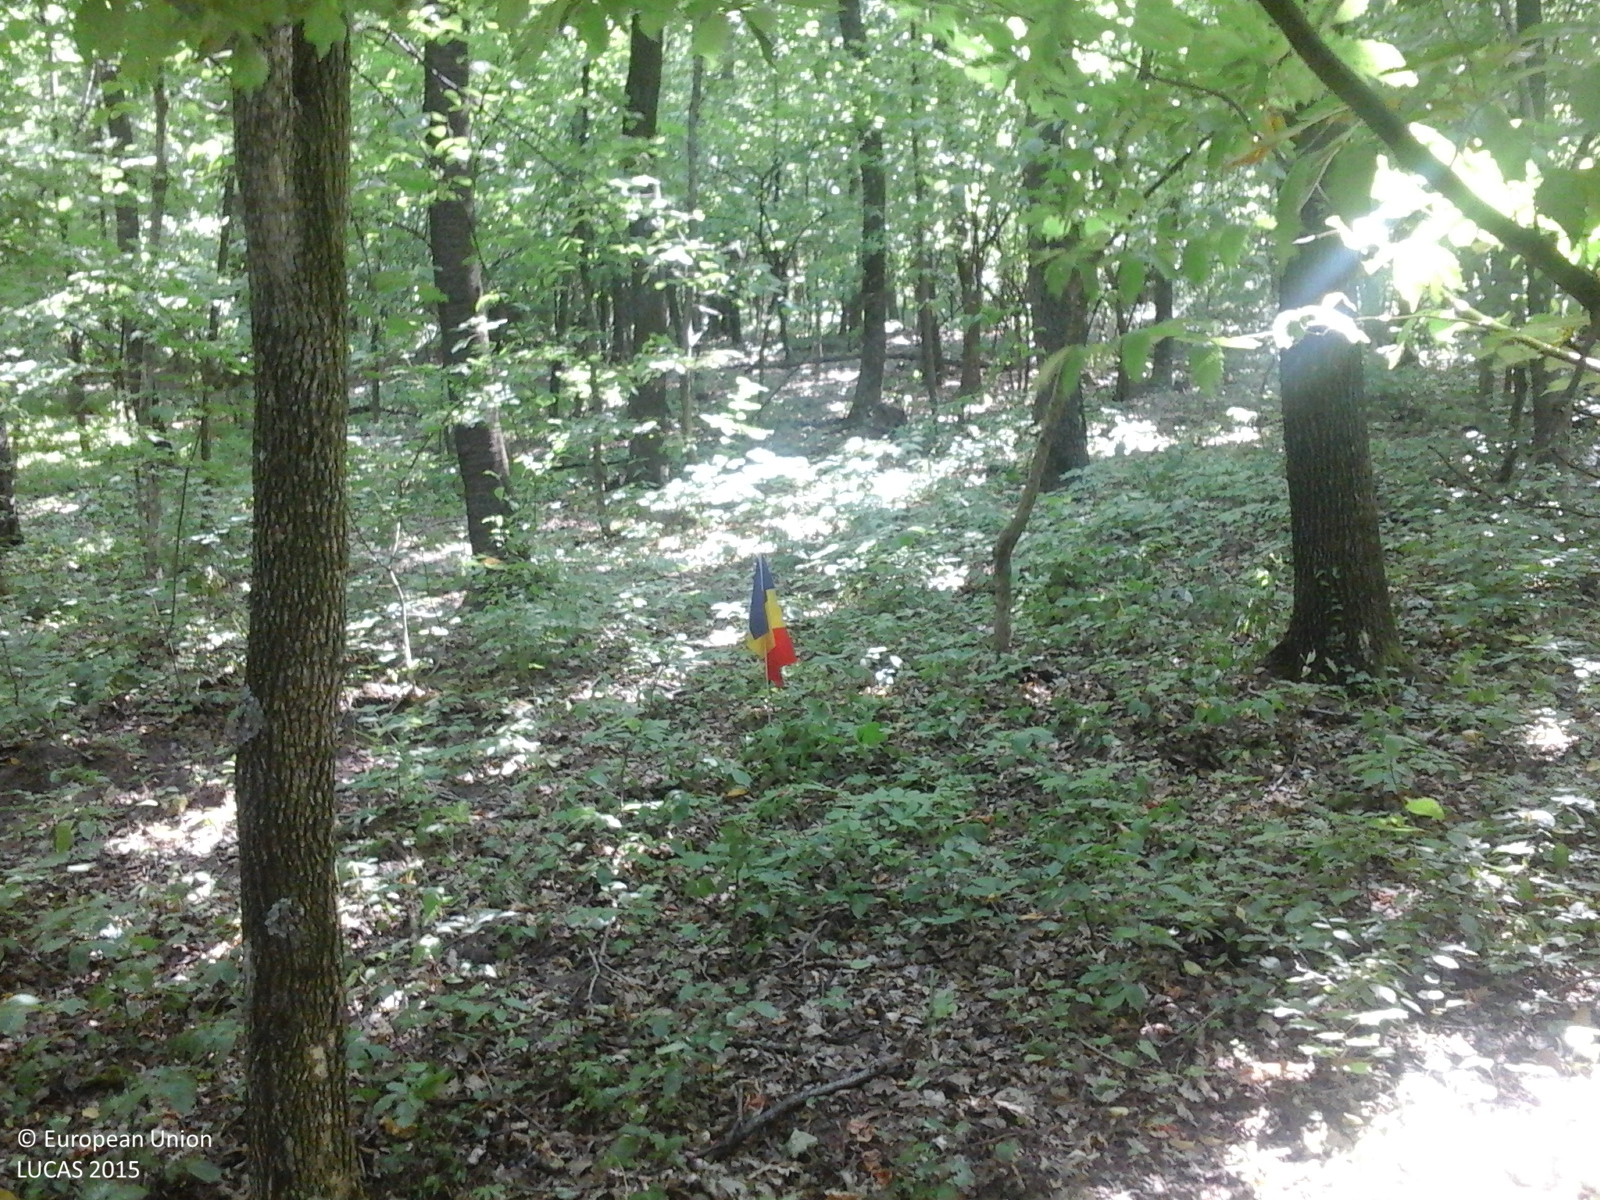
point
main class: Woodland
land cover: Broadleaved woodland
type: beech forest
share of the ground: > 75 %
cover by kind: broadleaved forest trees 90 %, herbaceous plants 10 %
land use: Forestry
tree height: > 5 m
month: June
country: RO
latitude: 46.7271
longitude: 27.9886
